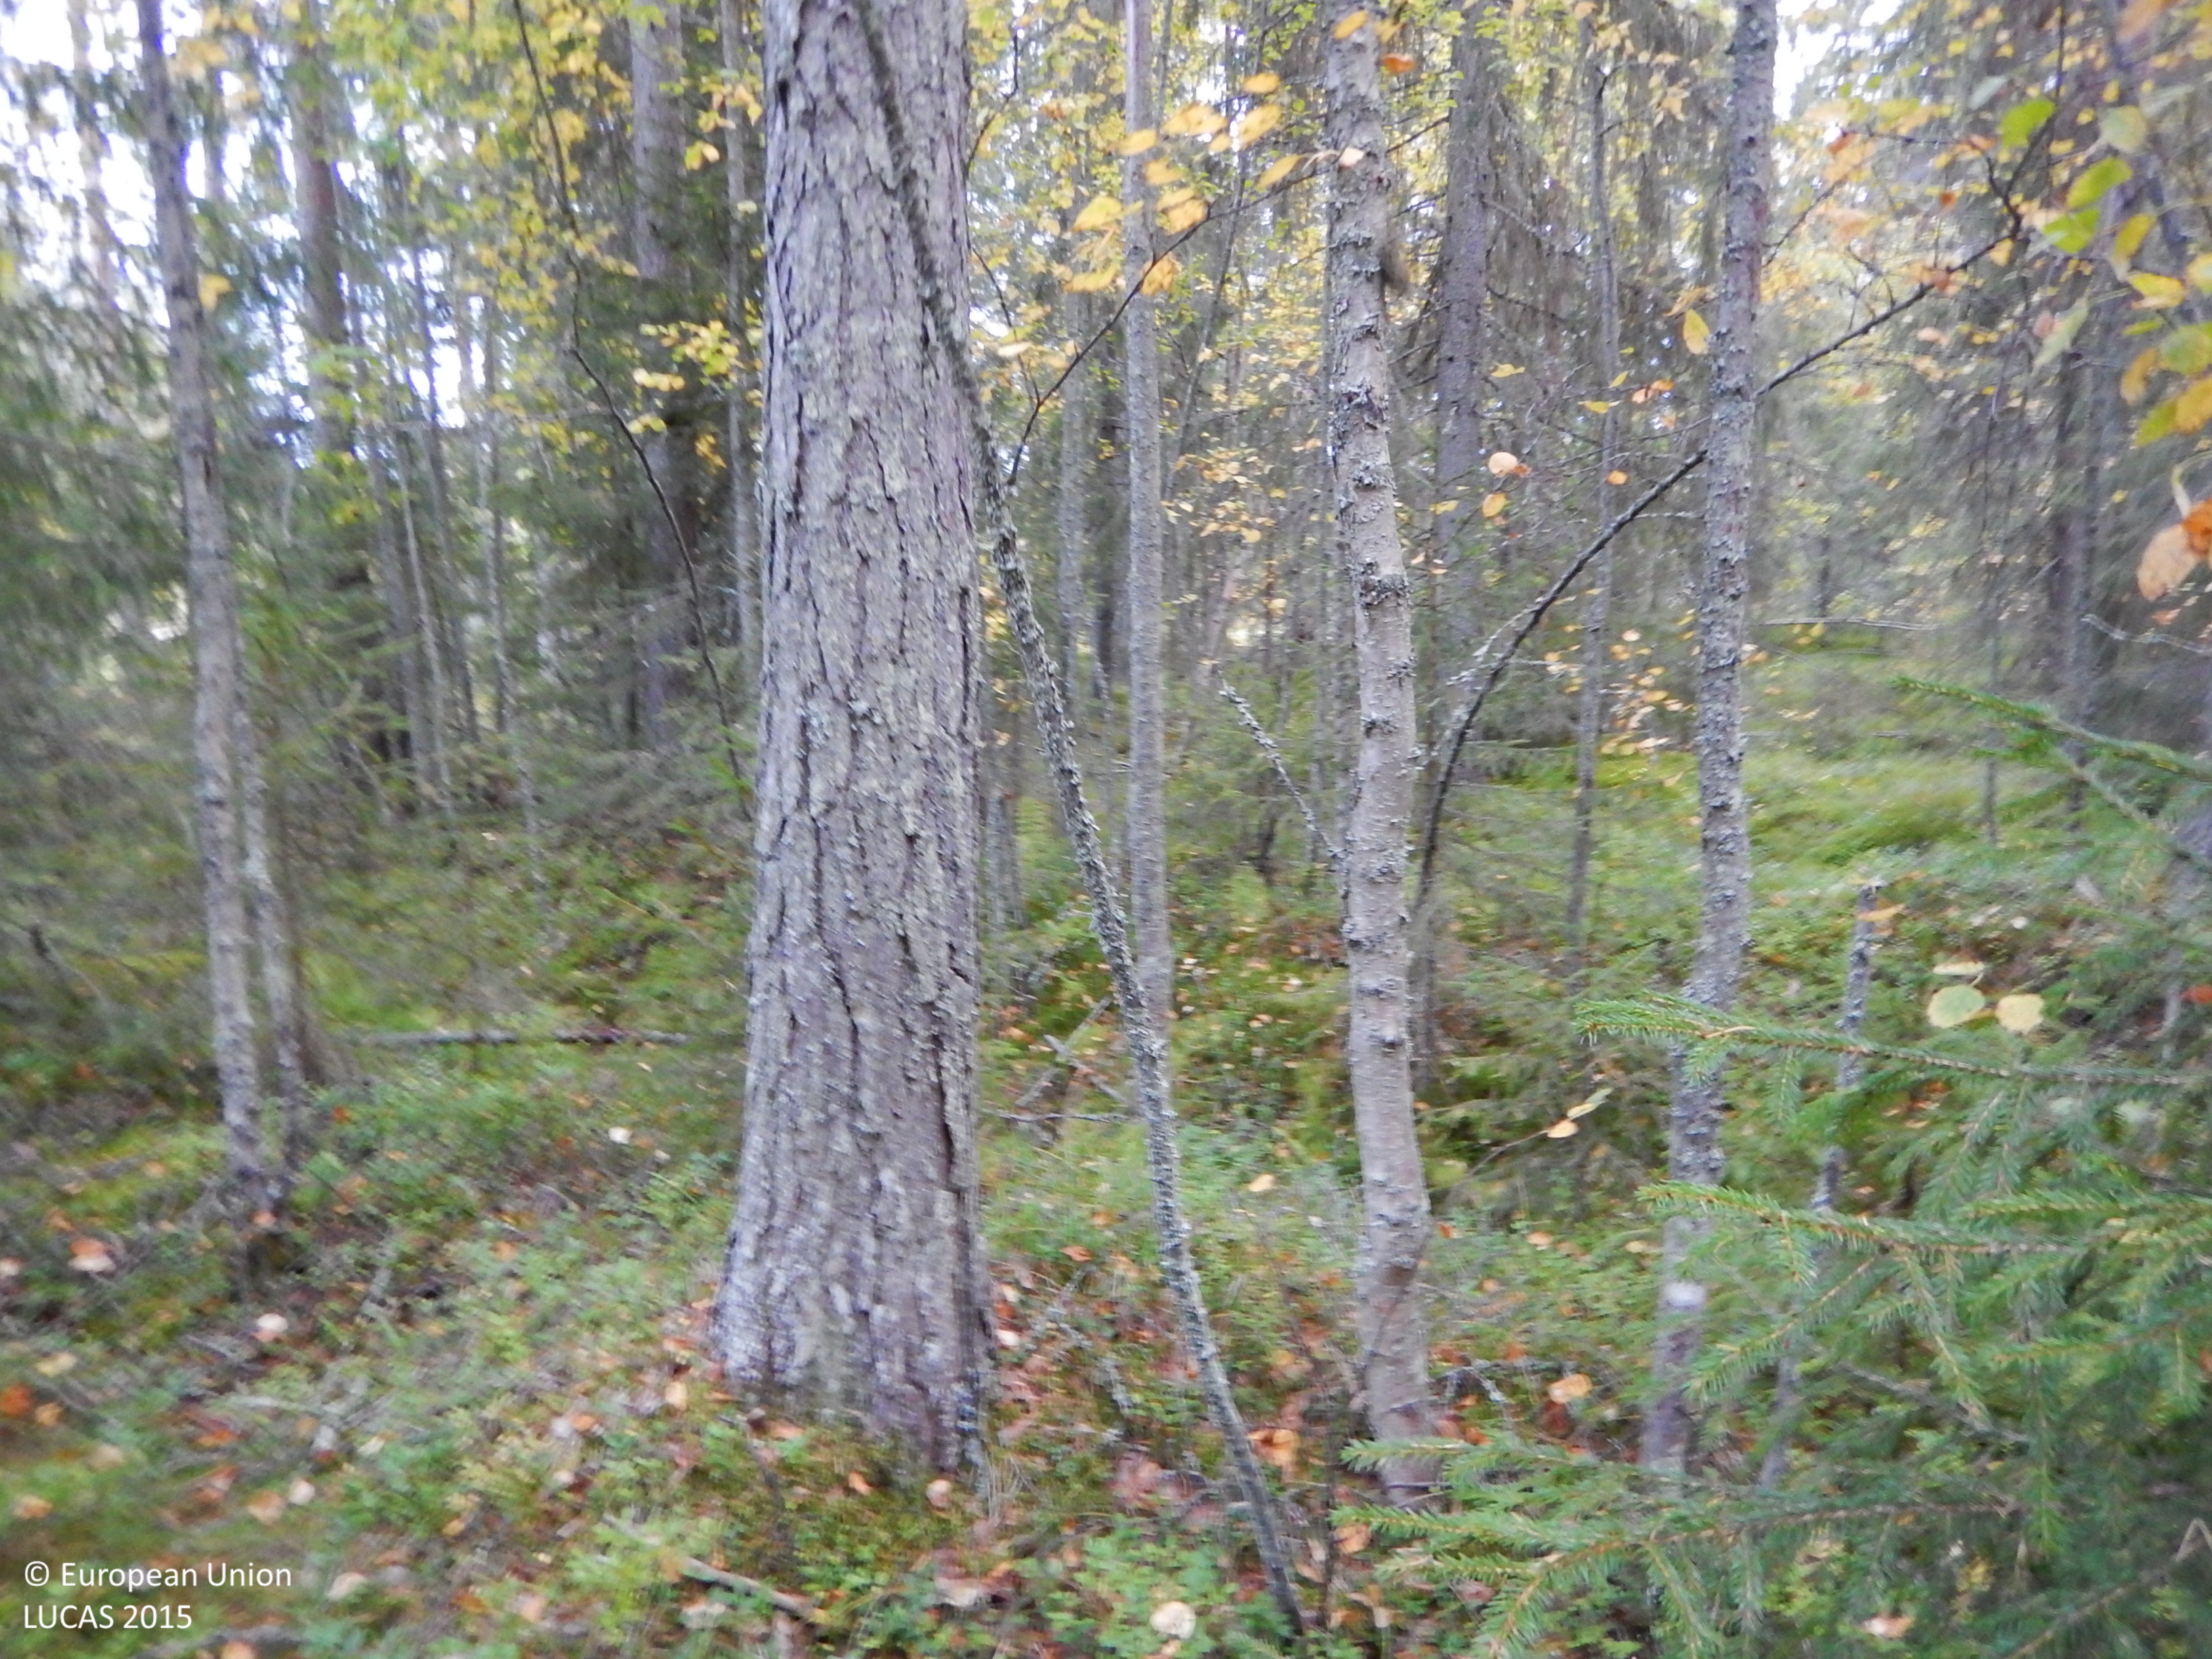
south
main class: Woodland
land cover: Other coniferous woodland
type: boreal forest
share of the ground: 50 - 75 %
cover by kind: coniferous forest trees 45 %, shrubs 25 %, broadleaved forest trees 15 %, lichens and mosses 15 %
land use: Forestry
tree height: > 5 m
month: September
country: SE
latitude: 64.7490
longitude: 20.1201
